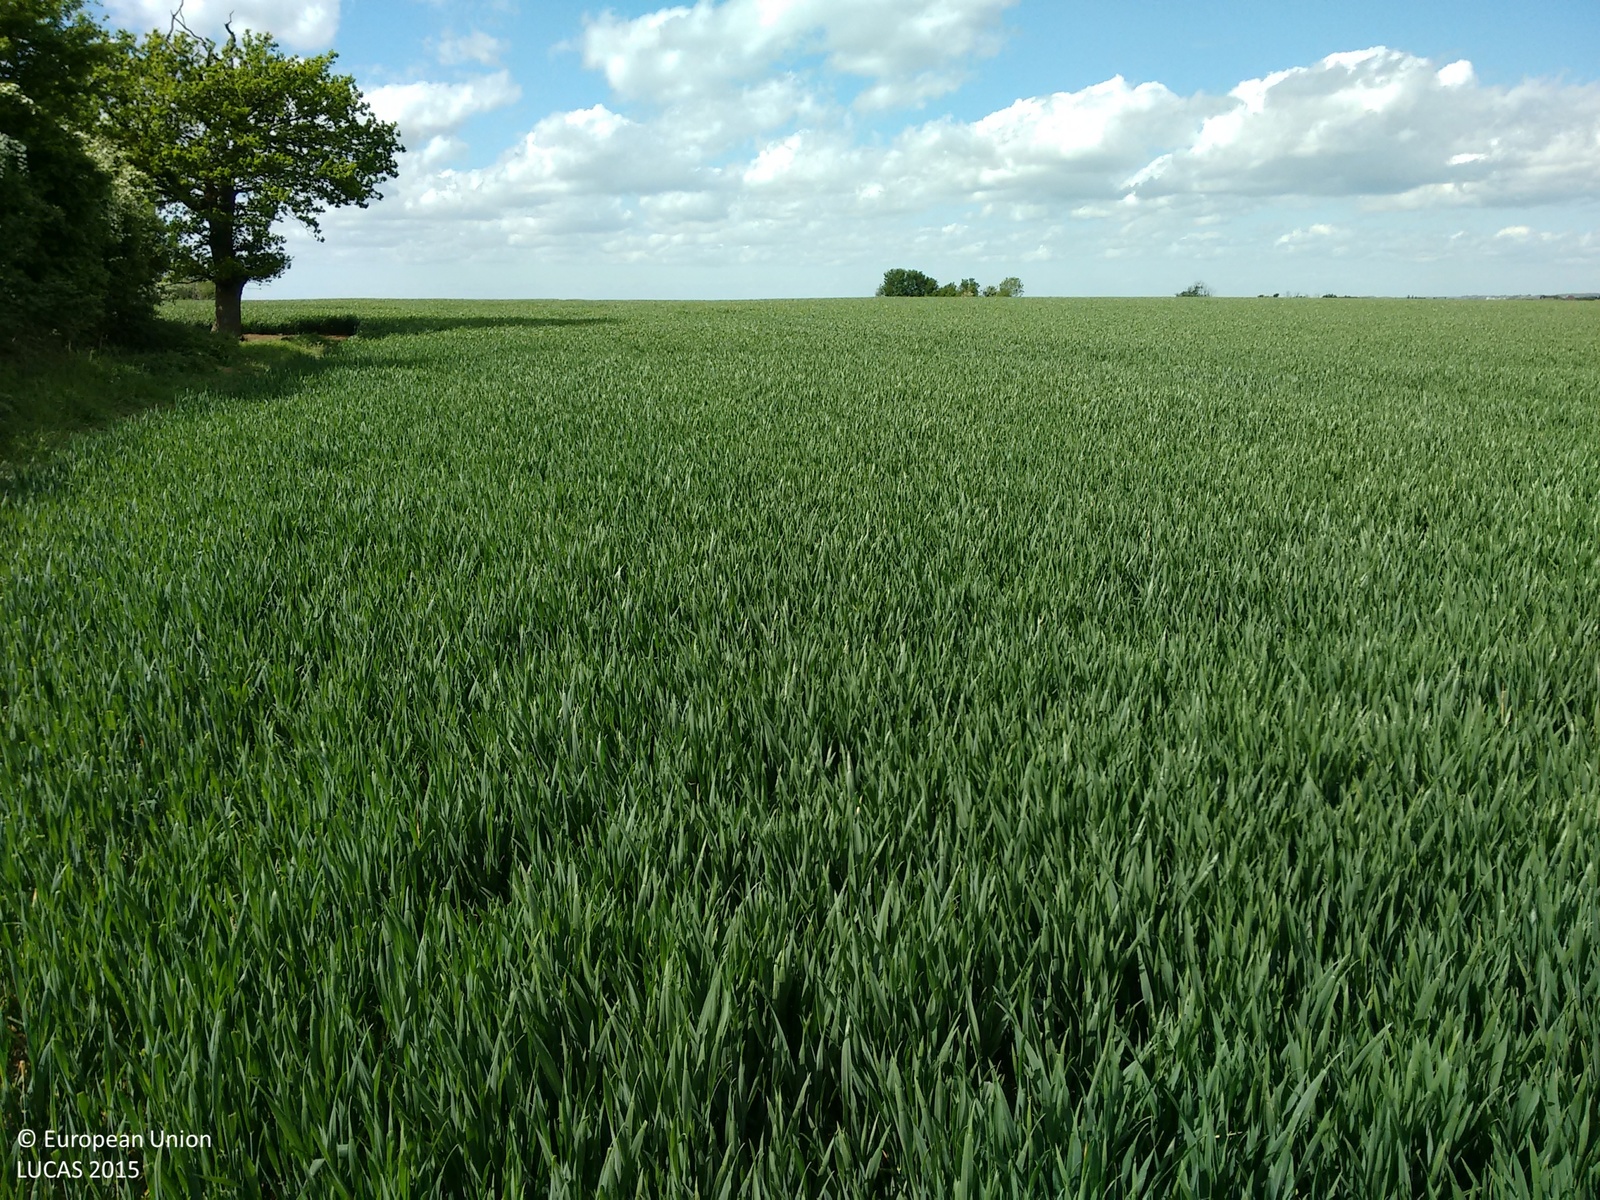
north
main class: Cropland
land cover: Common wheat
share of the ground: > 75 %
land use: Agriculture (excluding fallow land and kitchen gardens)
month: May
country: GB
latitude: 52.0763
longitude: -0.4703
